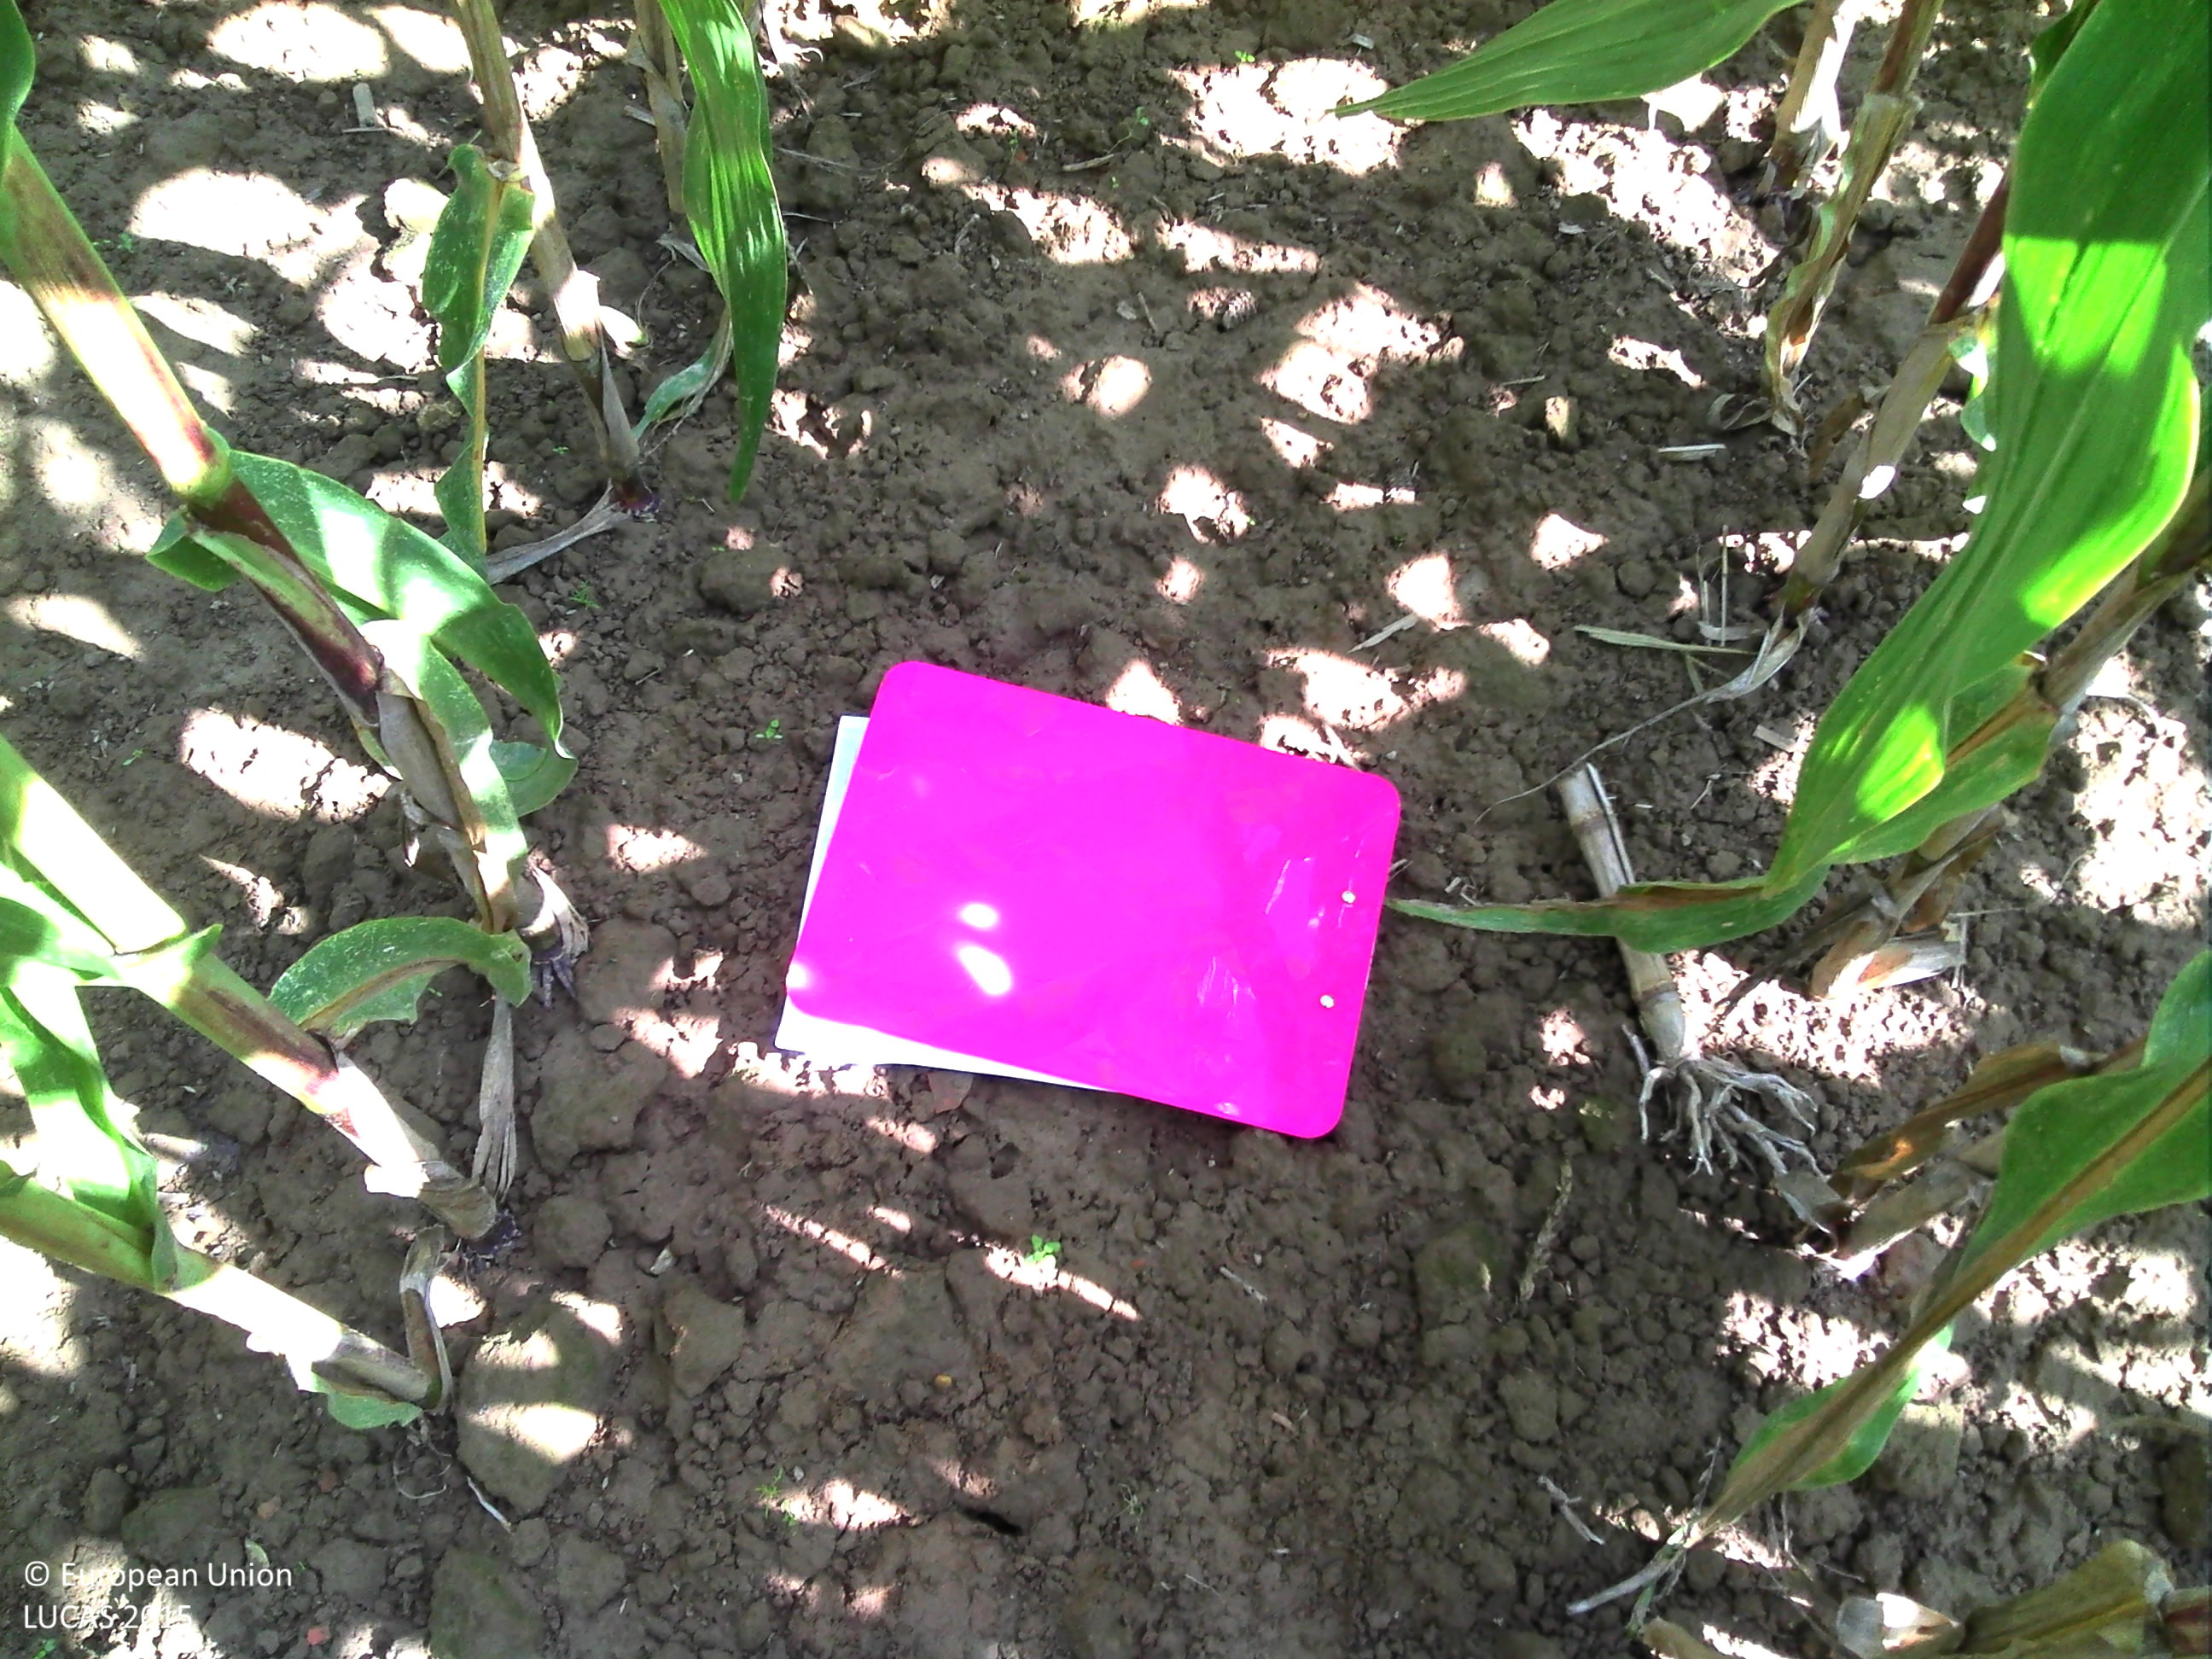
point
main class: Cropland
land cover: Maize
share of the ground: > 75 %
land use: Agriculture (excluding fallow land and kitchen gardens)
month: September
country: FR
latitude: 48.4534
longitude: 4.6297
